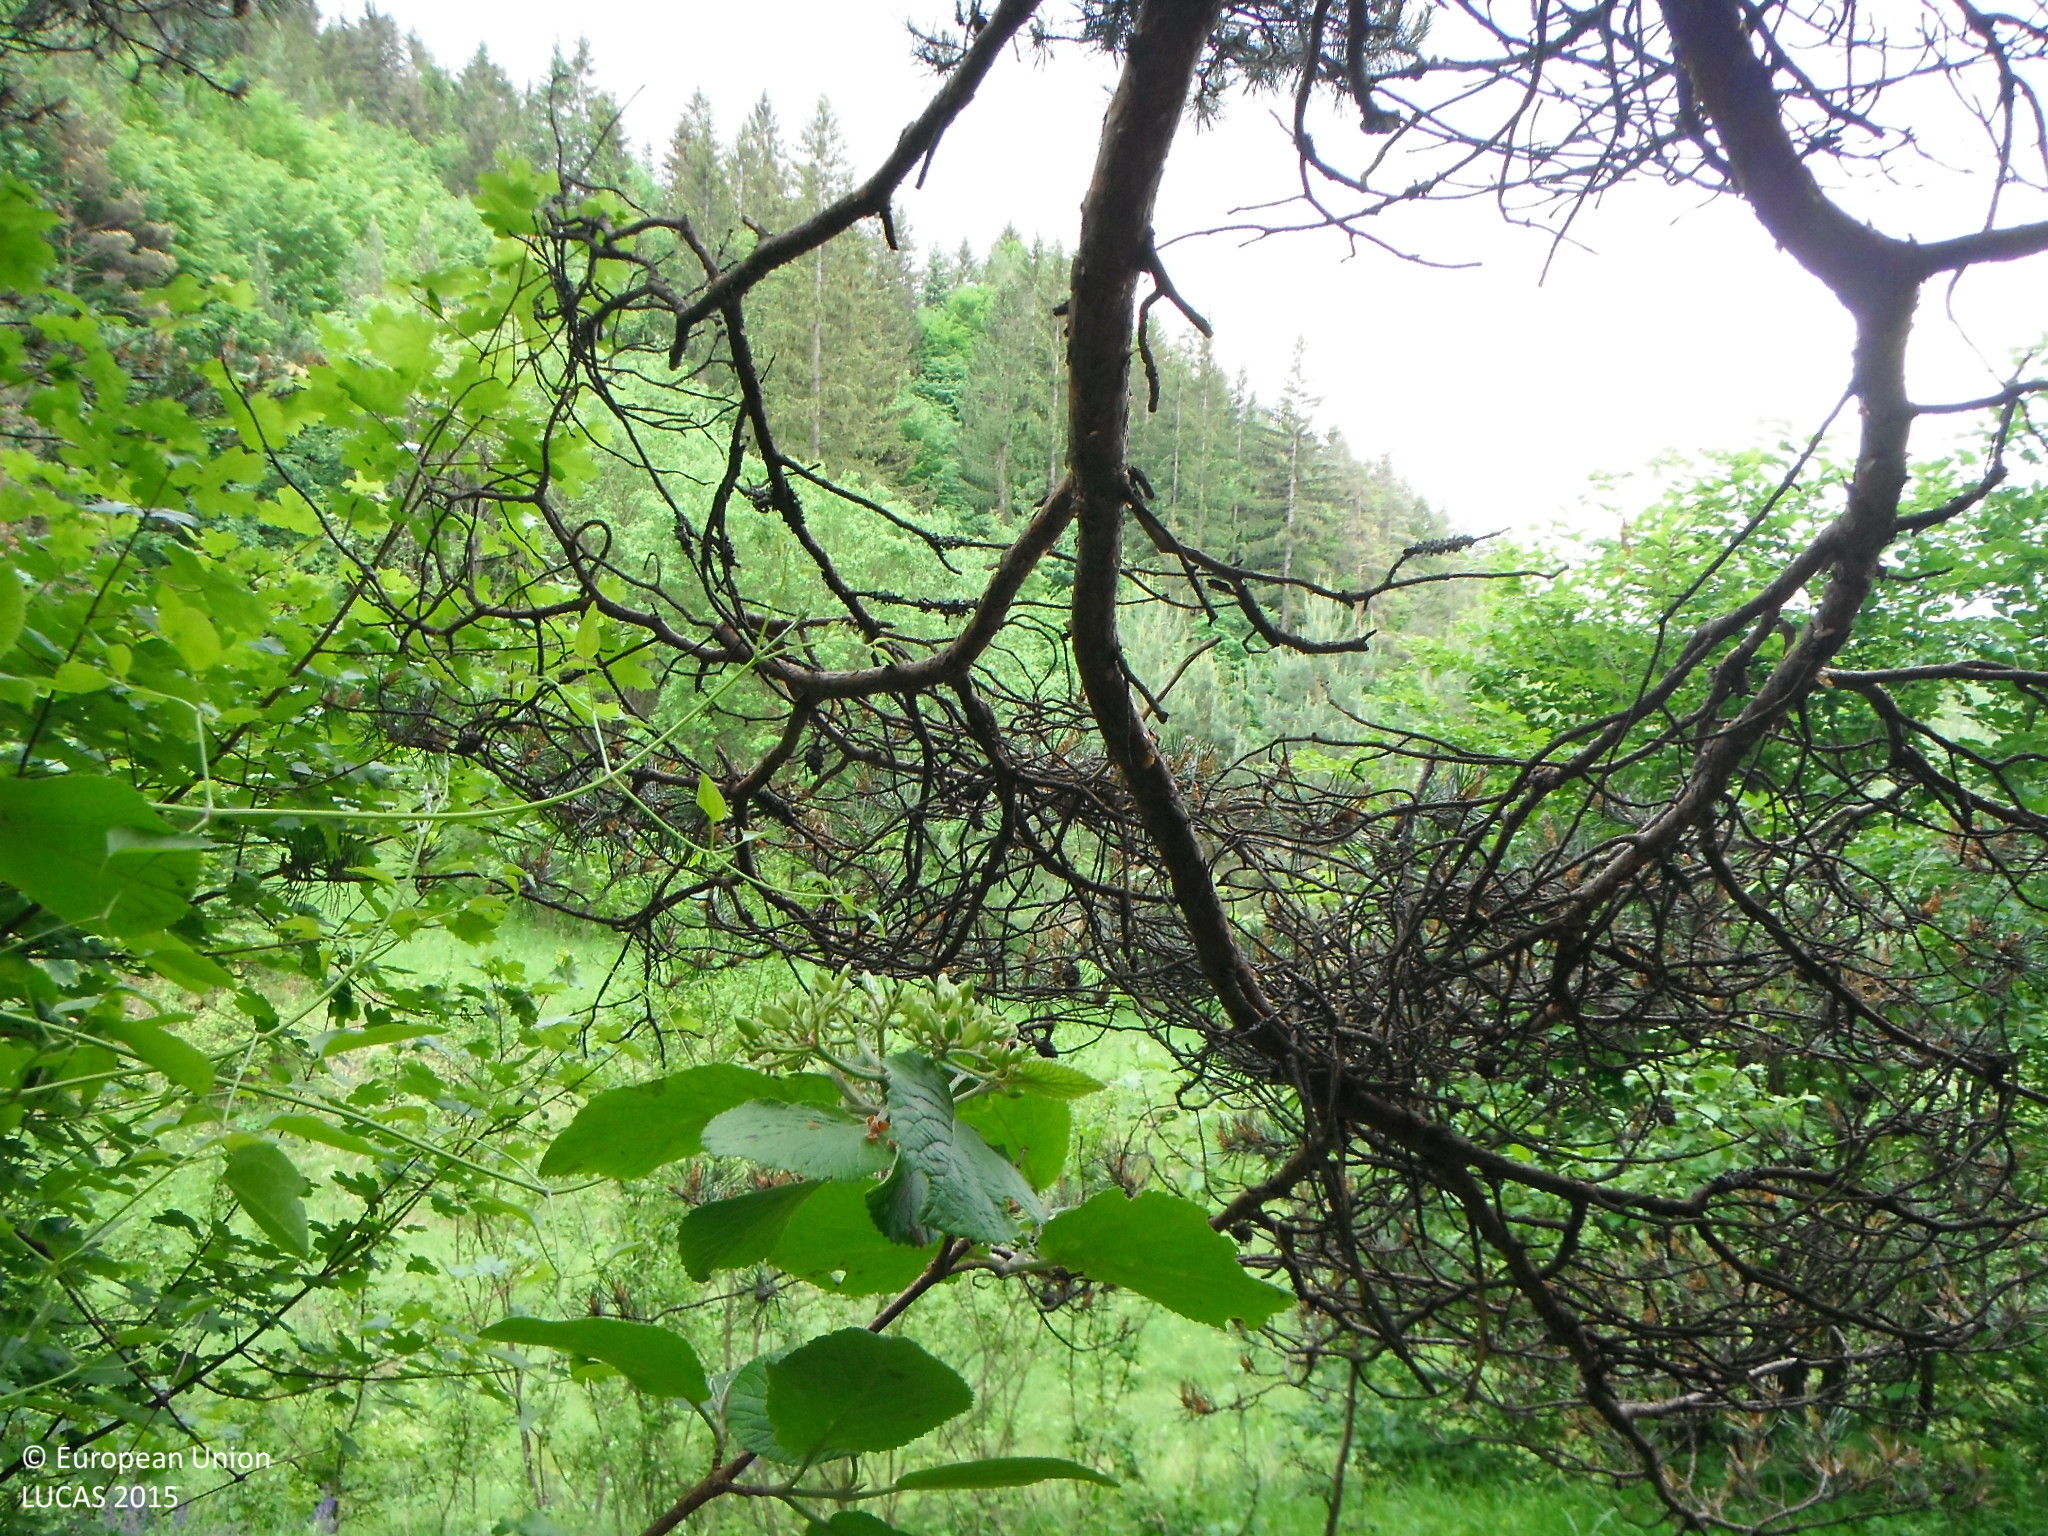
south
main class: Woodland
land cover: Pine dominated mixed woodland
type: hemiboreal forest and nemoral coniferous forest and mixed broadleaved-coniferous forest
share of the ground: > 75 %
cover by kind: coniferous forest trees 75 %, broadleaved forest trees 25 %
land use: Forestry
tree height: > 5 m
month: May
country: SK
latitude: 48.7790
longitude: 19.2087
